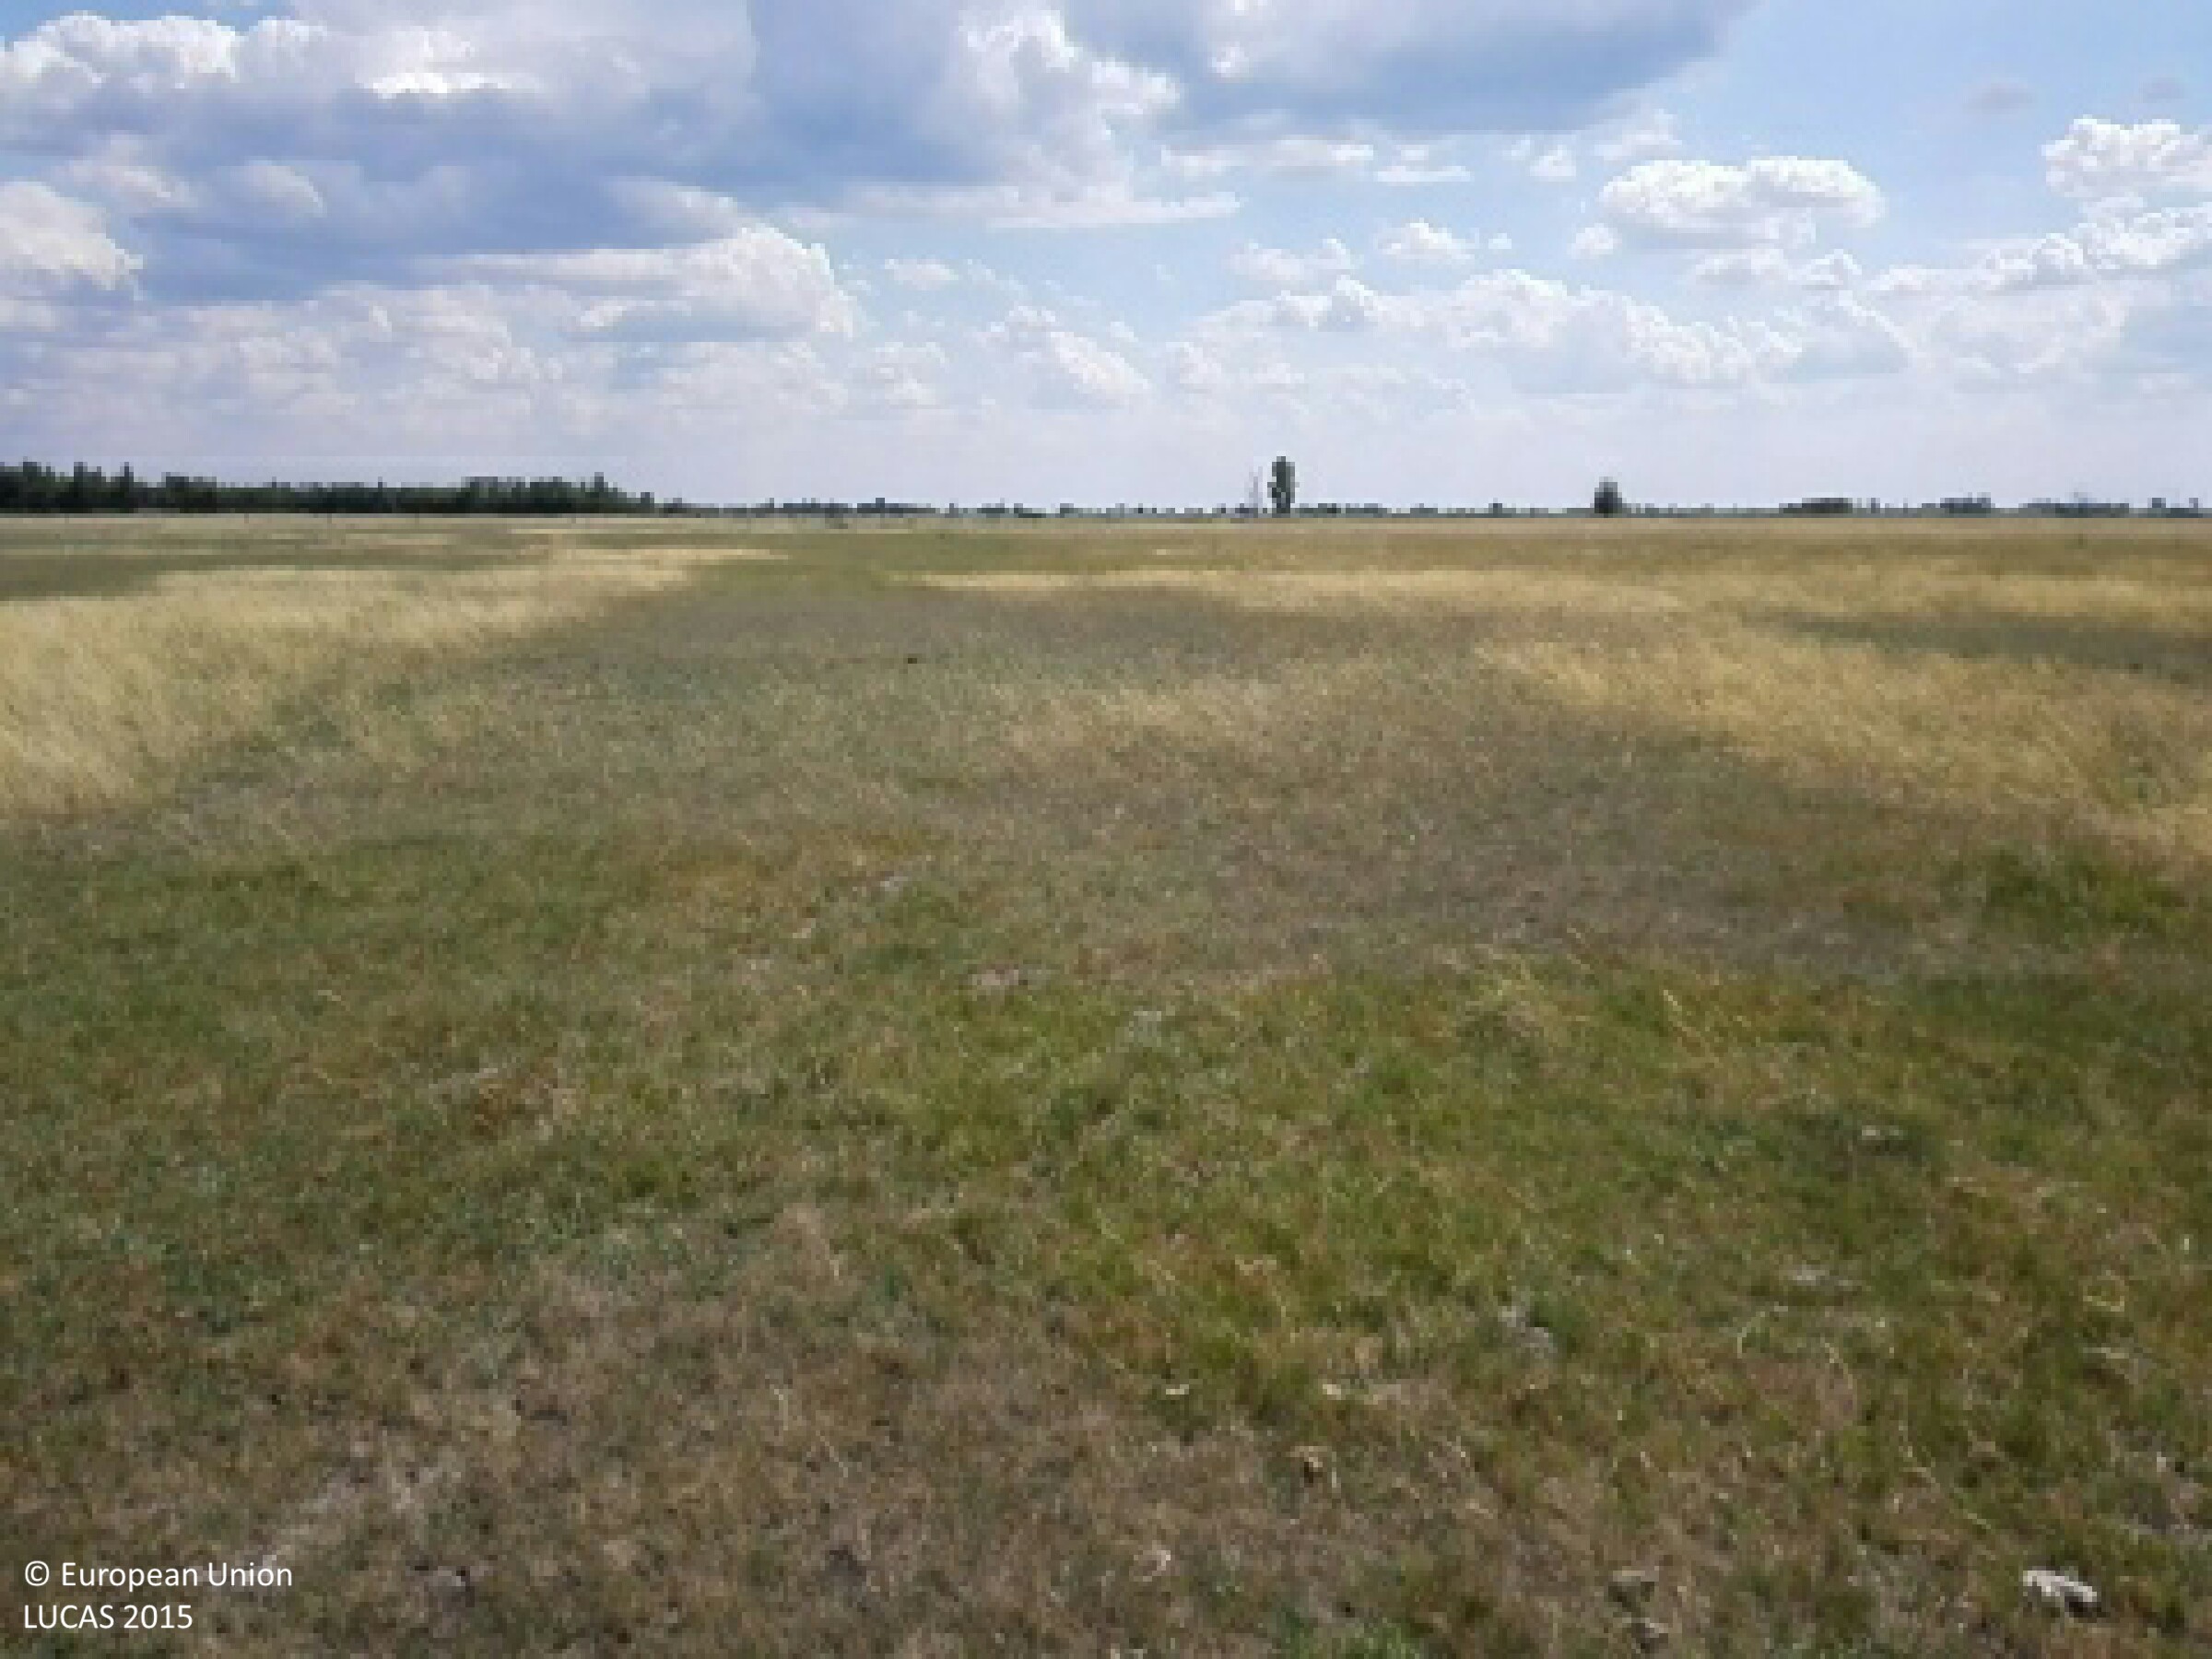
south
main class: Grassland
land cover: Grassland without tree/shrub cover
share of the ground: > 75 %
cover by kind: herbaceous plants 100 %
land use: Agriculture (excluding fallow land and kitchen gardens)
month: July
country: HU
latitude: 47.5119
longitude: 21.3137
